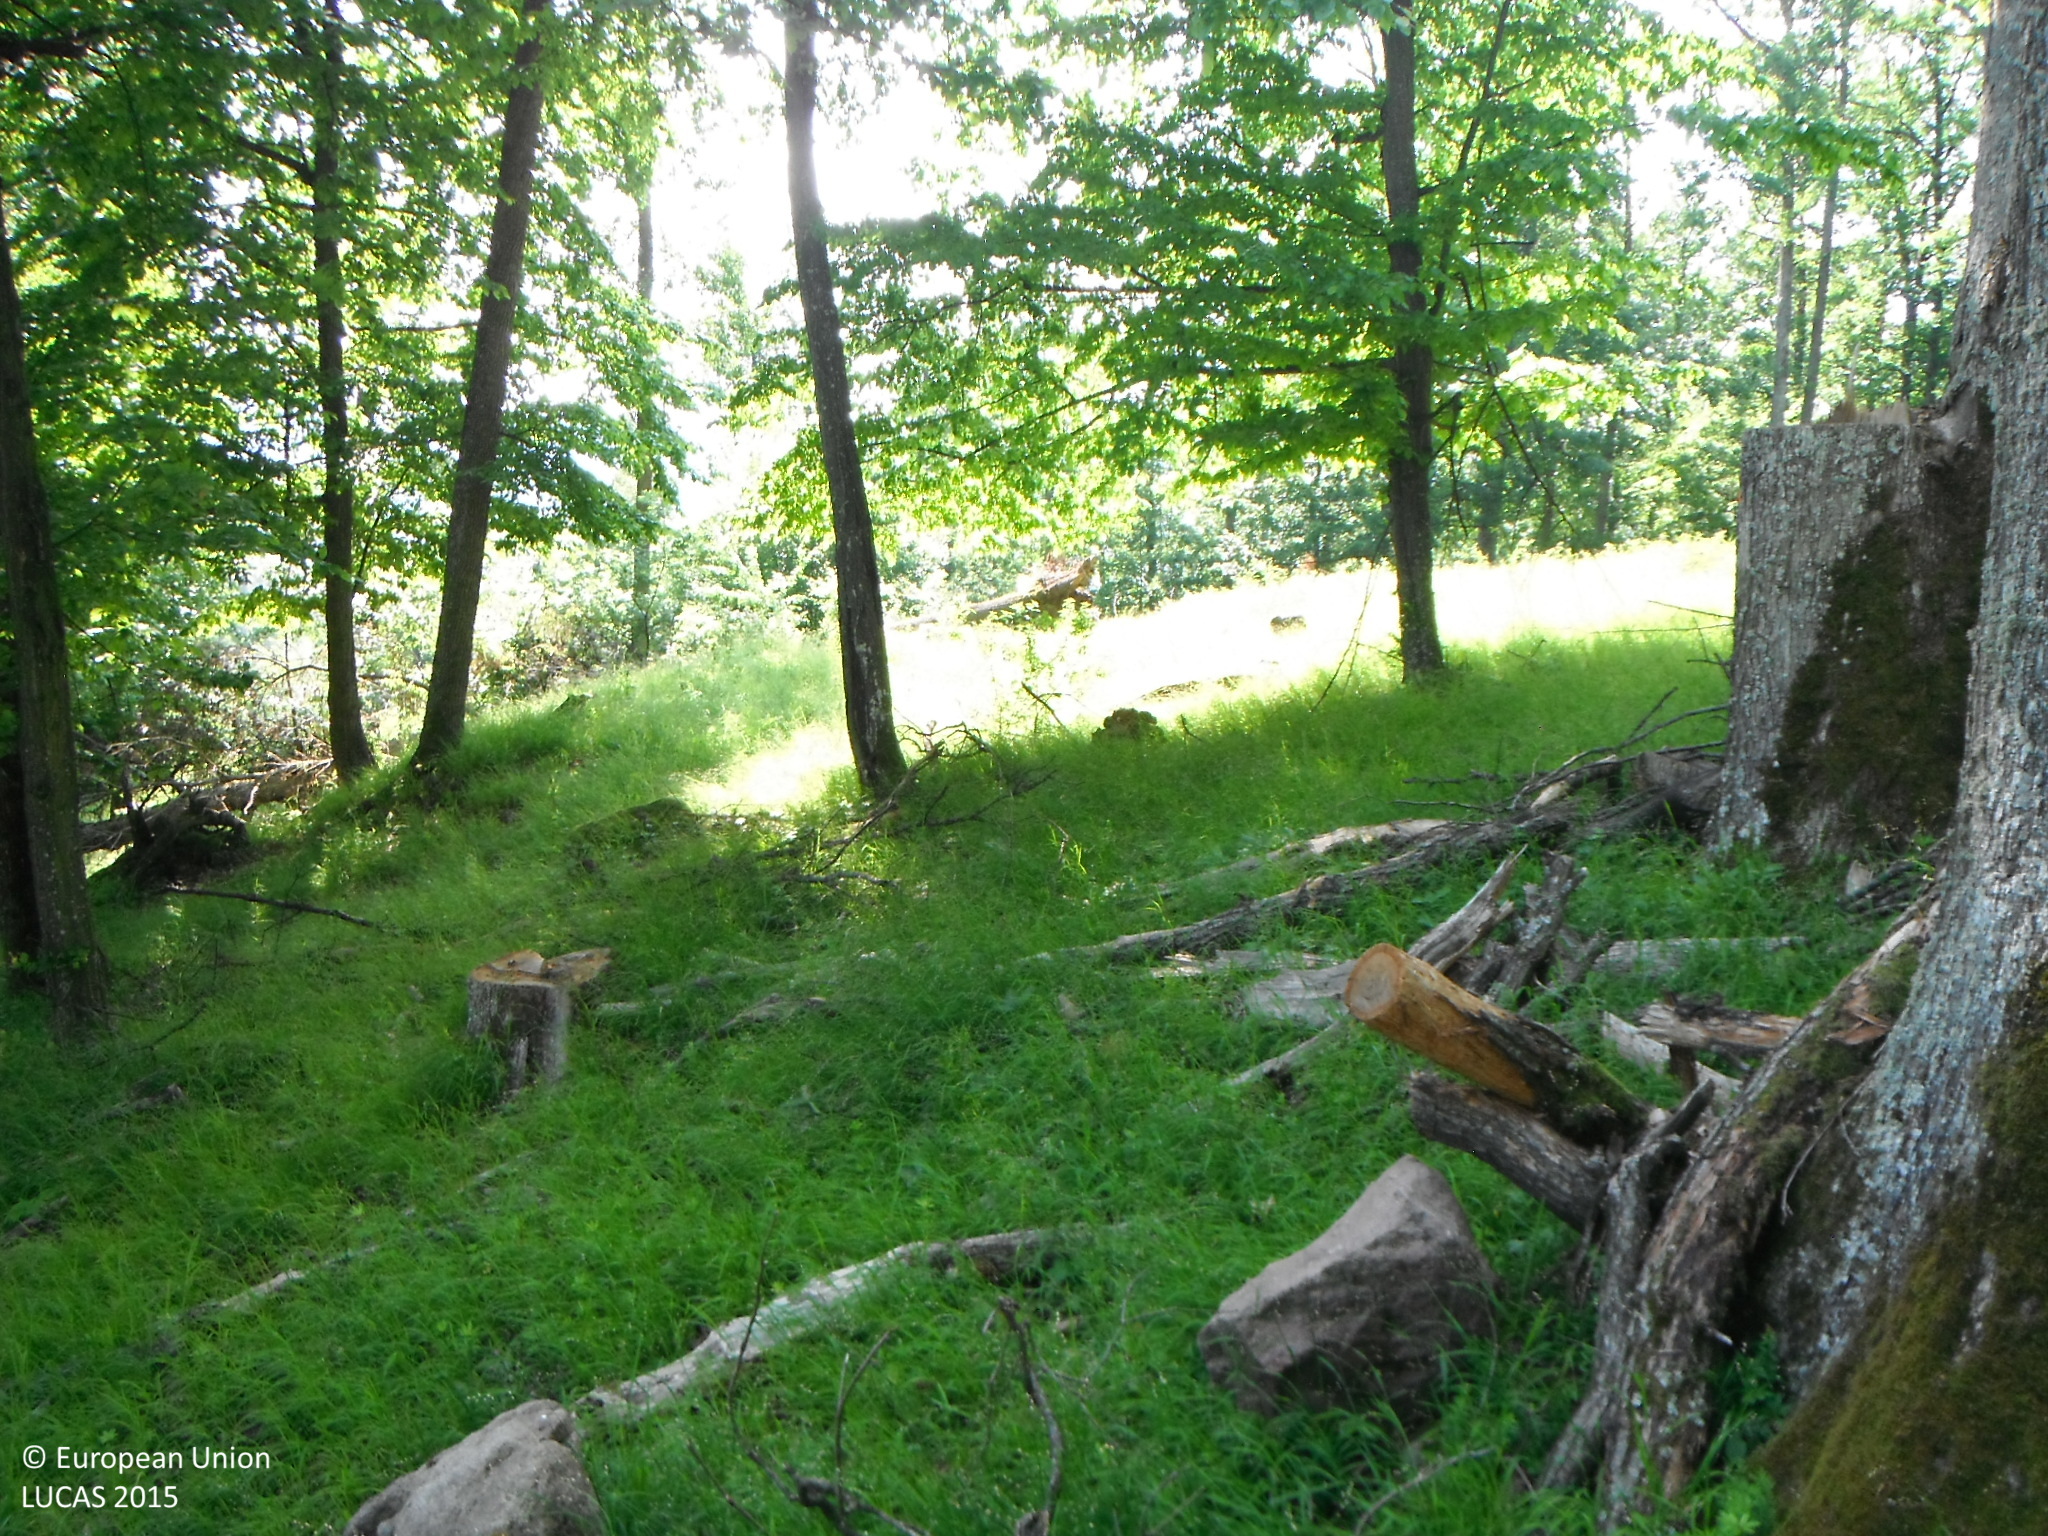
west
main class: Woodland
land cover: Broadleaved woodland
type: mesophytic deciduous forest
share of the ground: 50 - 75 %
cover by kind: broadleaved forest trees 75 %, herbaceous plants 25 %
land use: Forestry
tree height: > 5 m
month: May
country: SK
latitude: 48.3664
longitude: 18.9422
